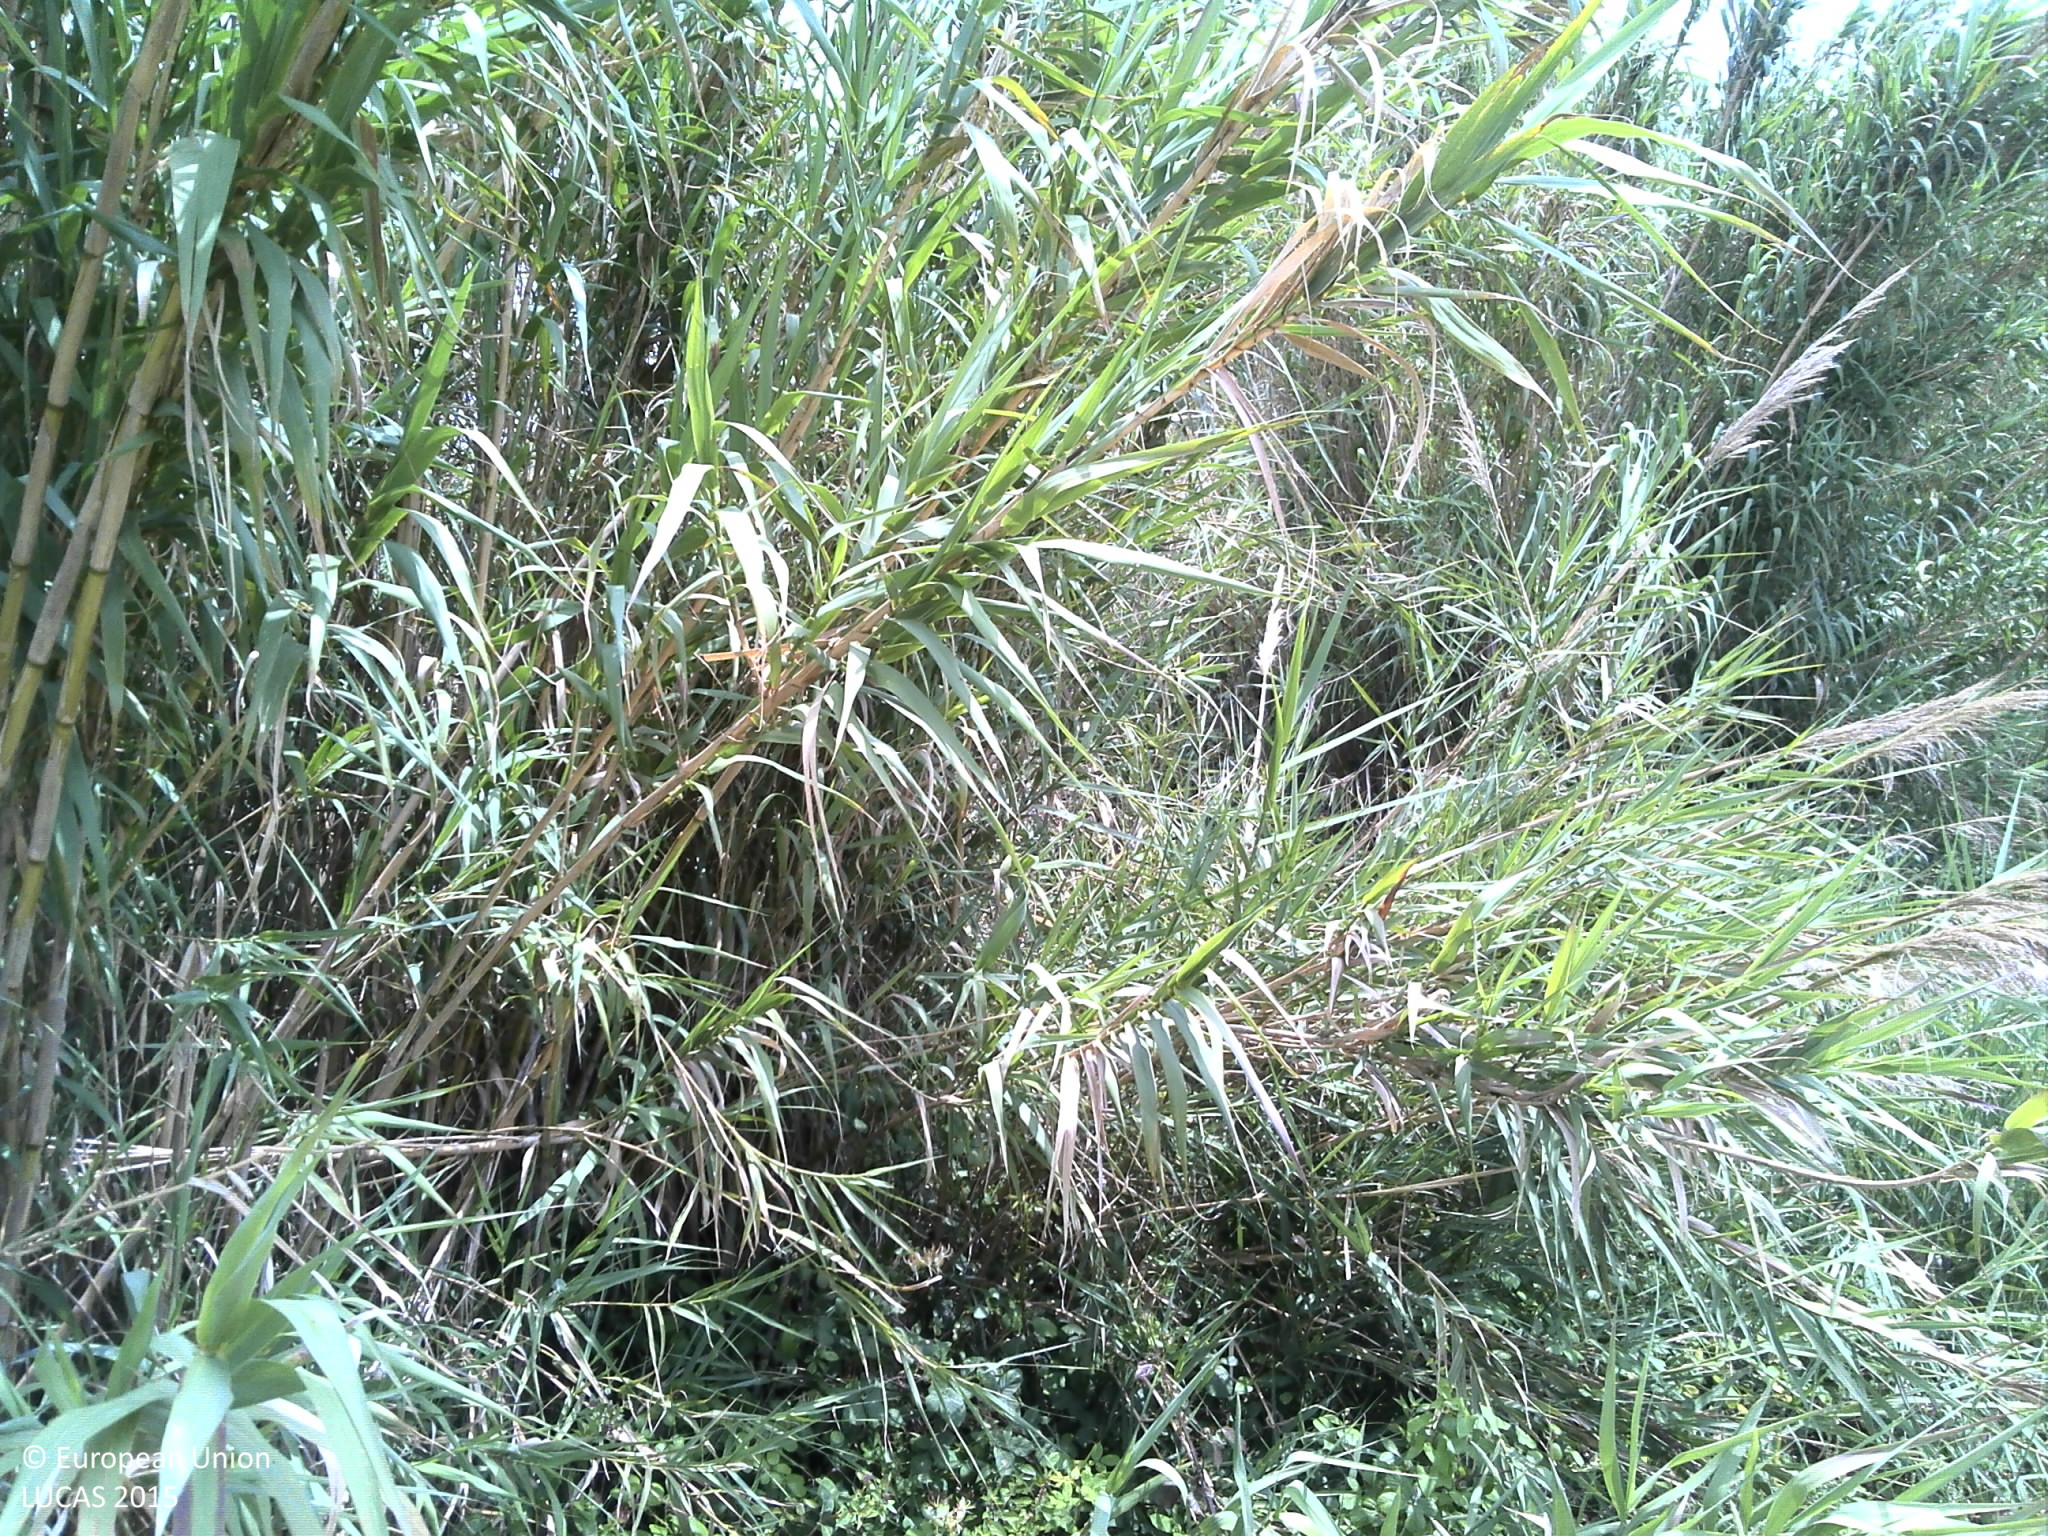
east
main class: Shrubland
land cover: Shrubland without tree cover
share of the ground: > 75 %
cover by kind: shrubs 60 %, unconsolidated bare surface 30 %, herbaceous plants 10 %
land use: Semi-natural and natural areas not in use
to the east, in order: Shrubland without tree cover; Tracks; Grass margins; Electric lines; Grassland without tree/shrub cover; Tracks; Shrubland without tree cover
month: June
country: PT
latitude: 39.3284
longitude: -9.3148
